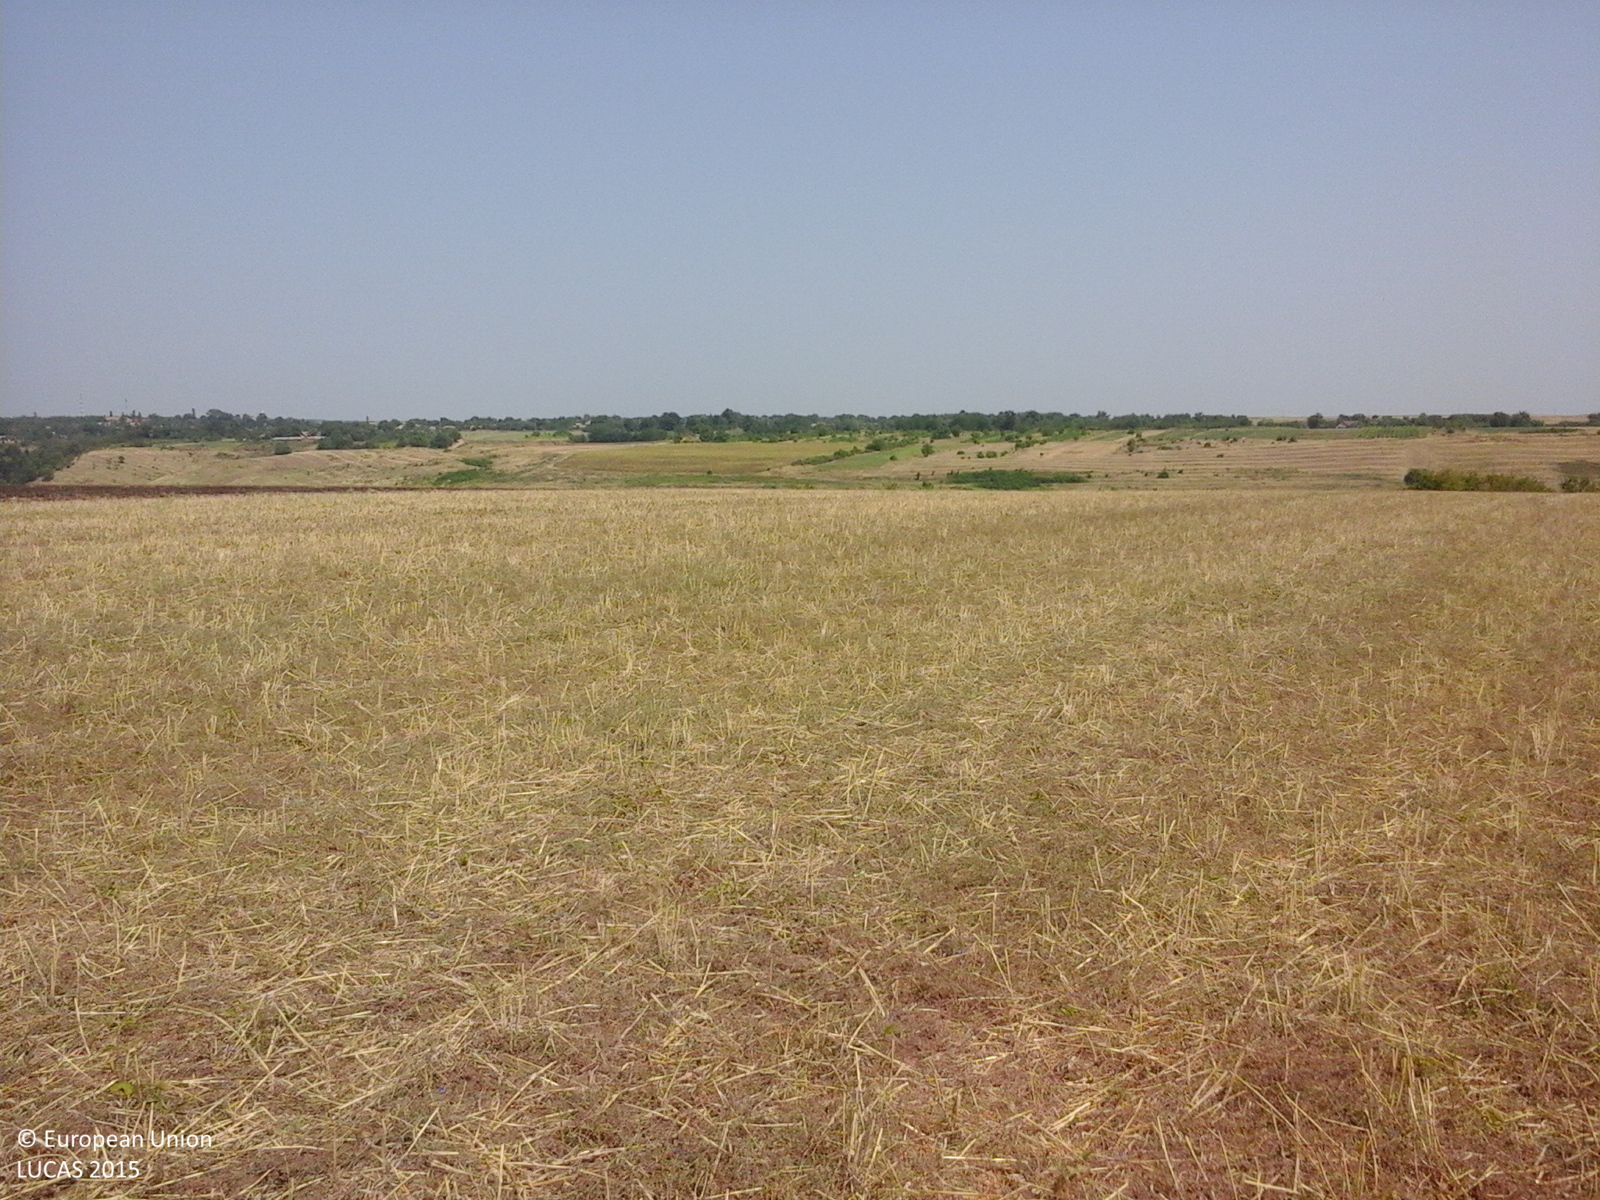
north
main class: Cropland
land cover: Common wheat
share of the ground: 50 - 75 %
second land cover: Spontaneously vegetated surfaces
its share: 50 - 75 %
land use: Agriculture (excluding fallow land and kitchen gardens)
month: August
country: RO
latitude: 44.2264
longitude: 23.2542
